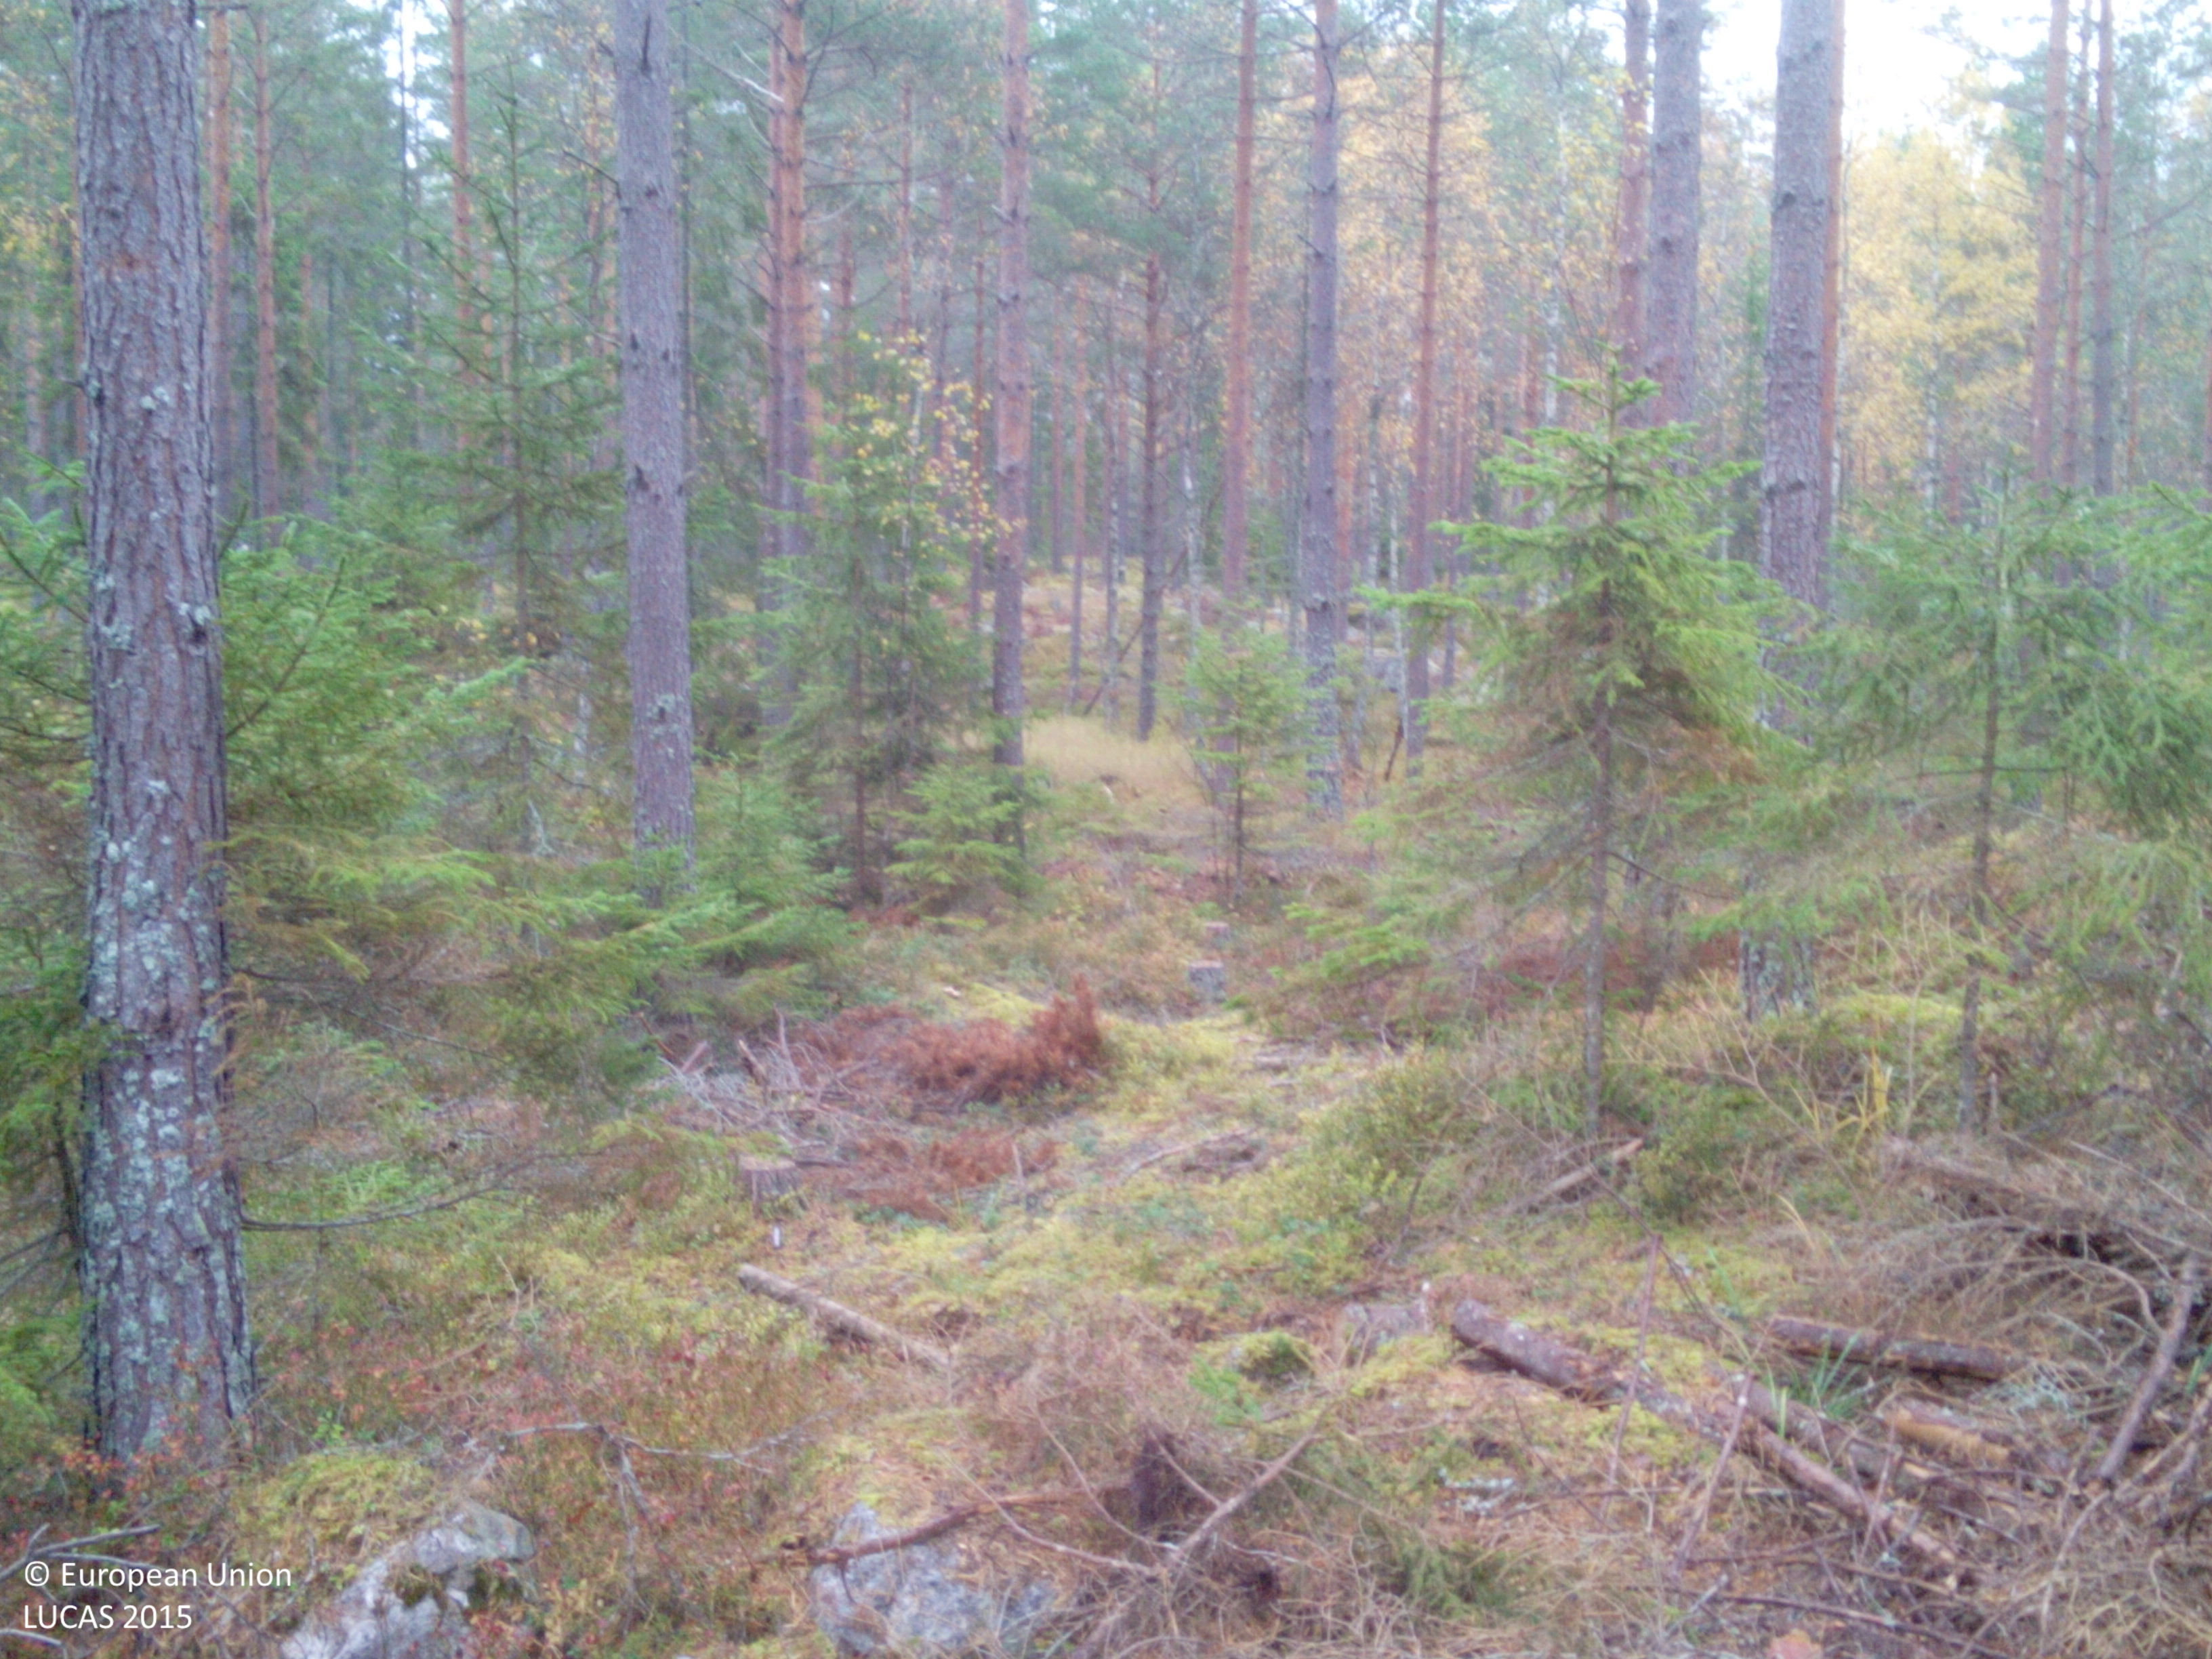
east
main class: Woodland
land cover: Other coniferous woodland
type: boreal forest
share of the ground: > 75 %
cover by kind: coniferous forest trees 85 %, lichens and mosses 10 %, herbaceous plants 5 %
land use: Forestry
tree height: > 5 m
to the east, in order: Other coniferous woodland; Other mixed woodland; Pine dominated coniferous woodland; Other mixed woodland; Tracks; Other coniferous woodland; Other mixed woodland
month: October
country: SE
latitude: 59.1415
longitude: 16.1984
